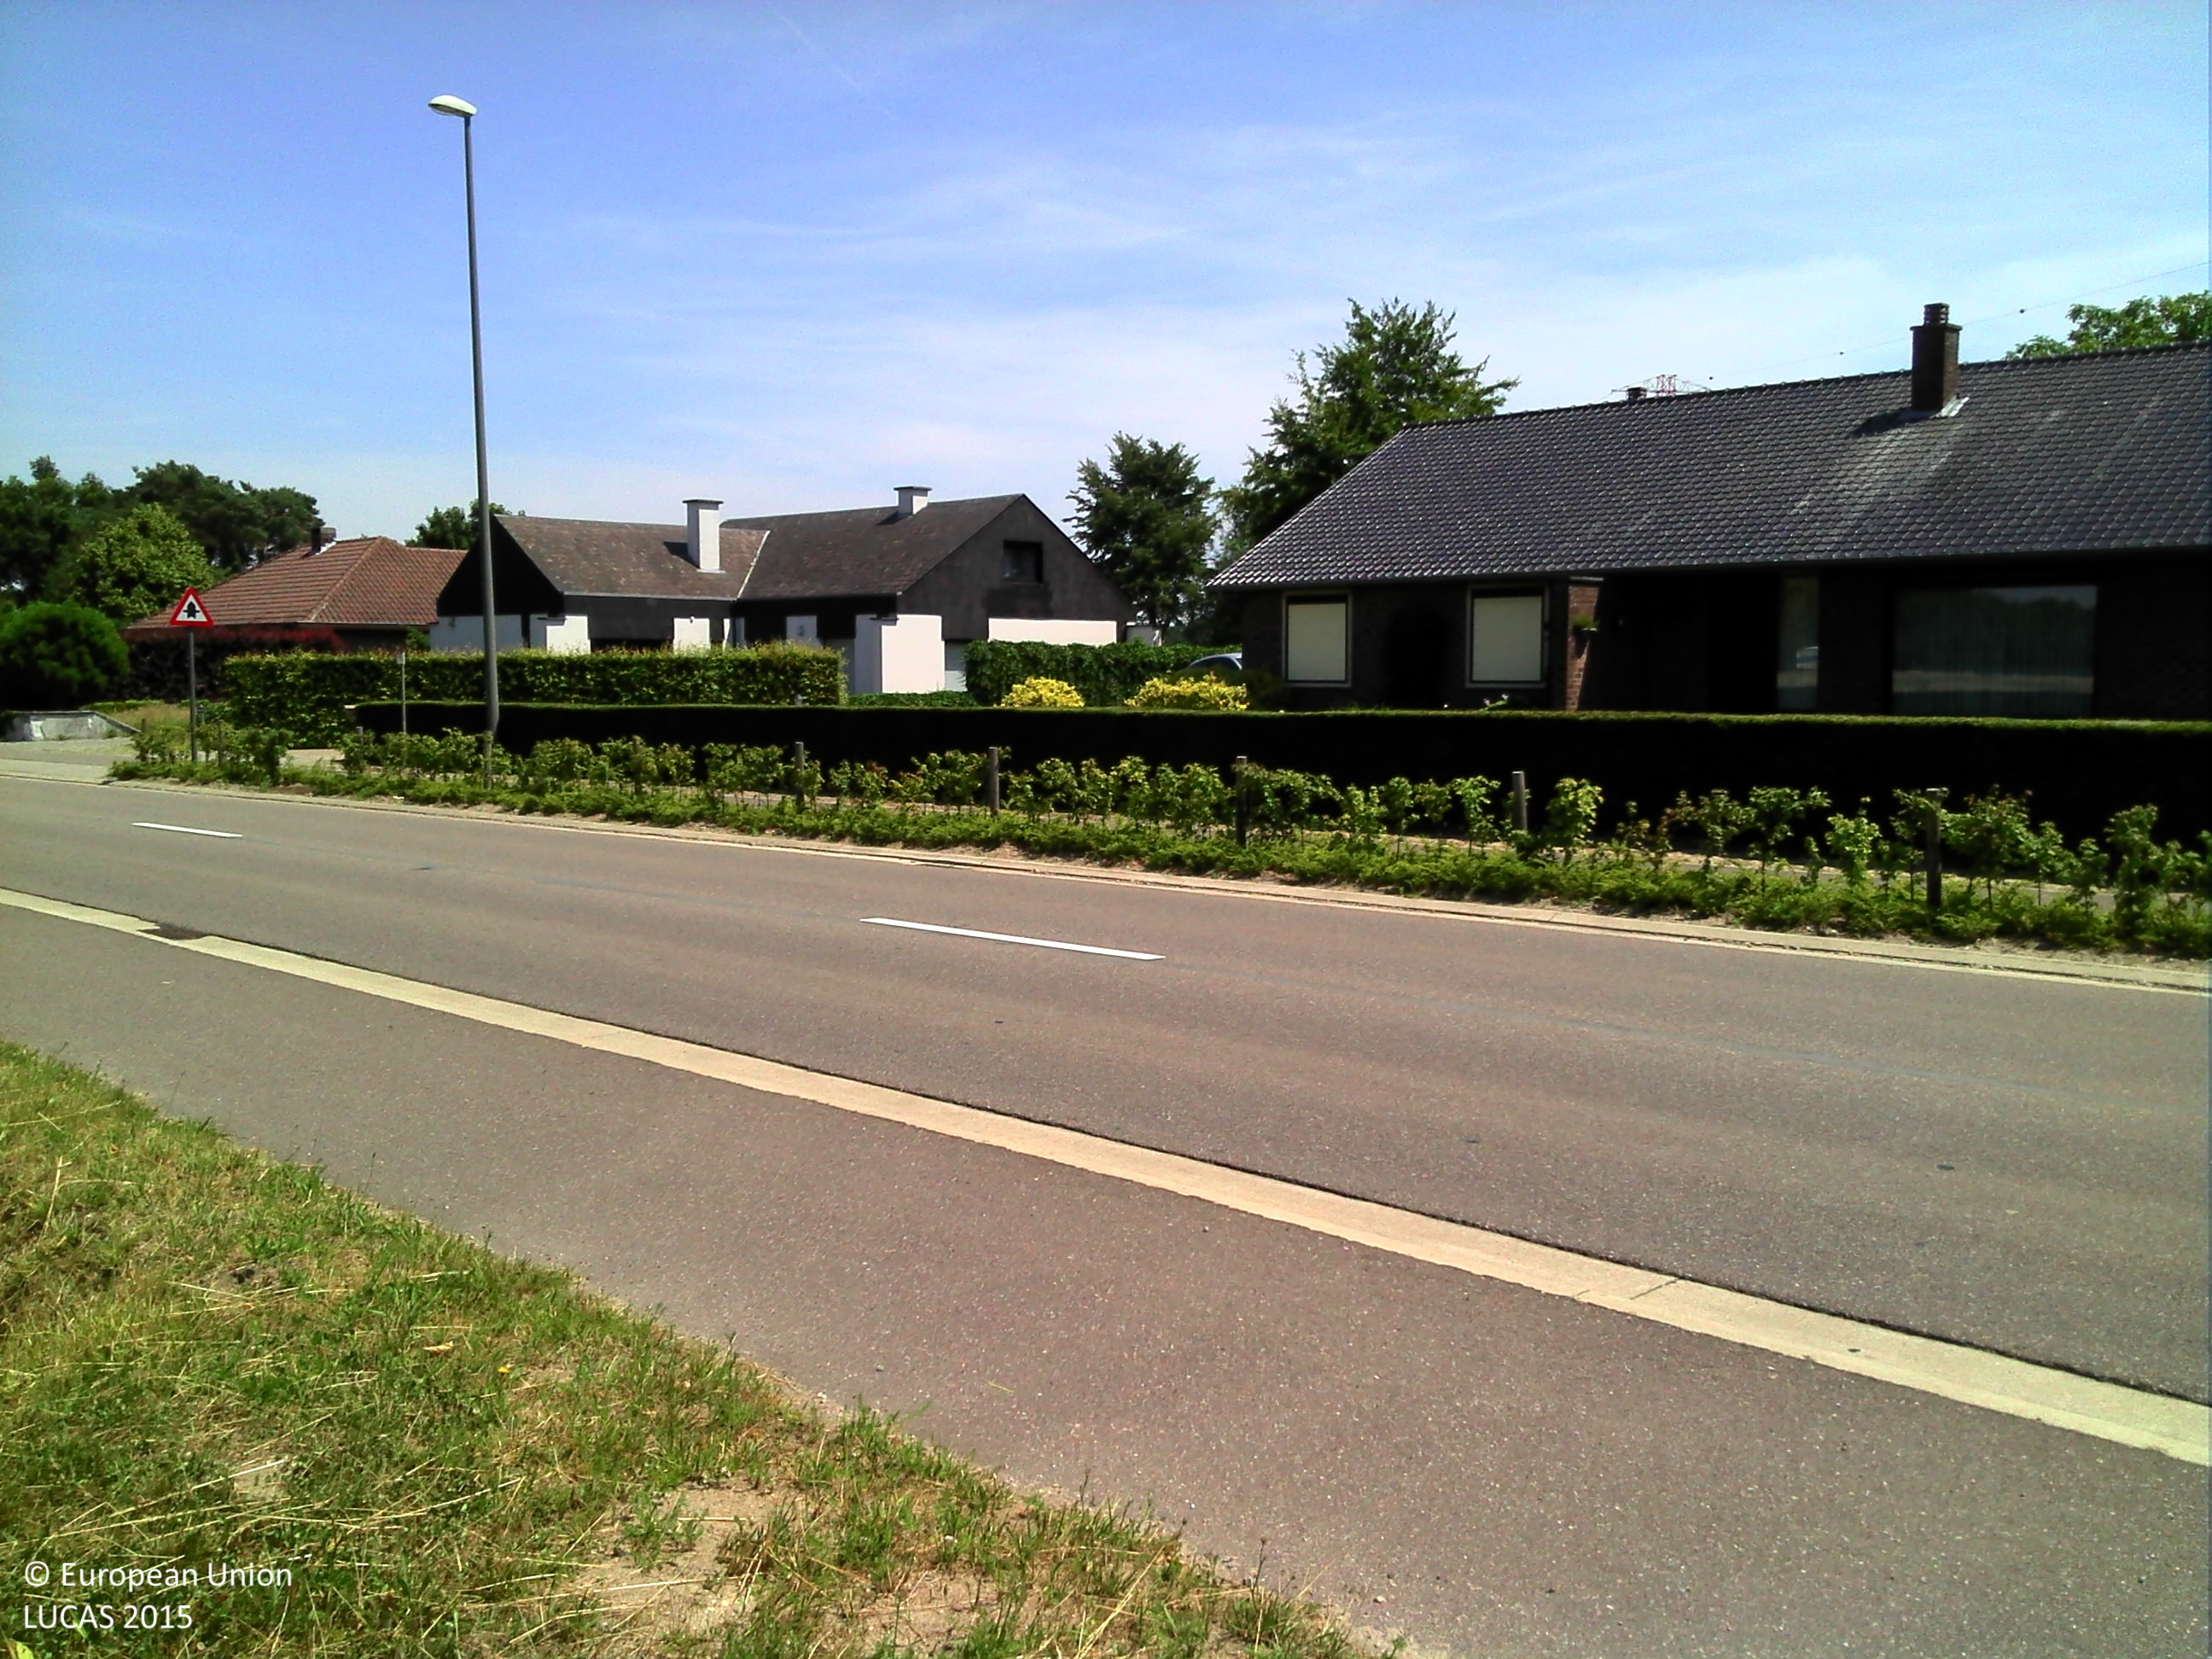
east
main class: Grassland
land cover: Grassland without tree/shrub cover
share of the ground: > 75 %
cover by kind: herbaceous plants 100 %
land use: Agriculture (excluding fallow land and kitchen gardens)
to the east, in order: Grassland without tree/shrub cover; Fences; Grass margins; Ditches and canals; Artificial constructions in urban areas; Maize
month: July
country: BE
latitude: 51.1387
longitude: 5.4674
